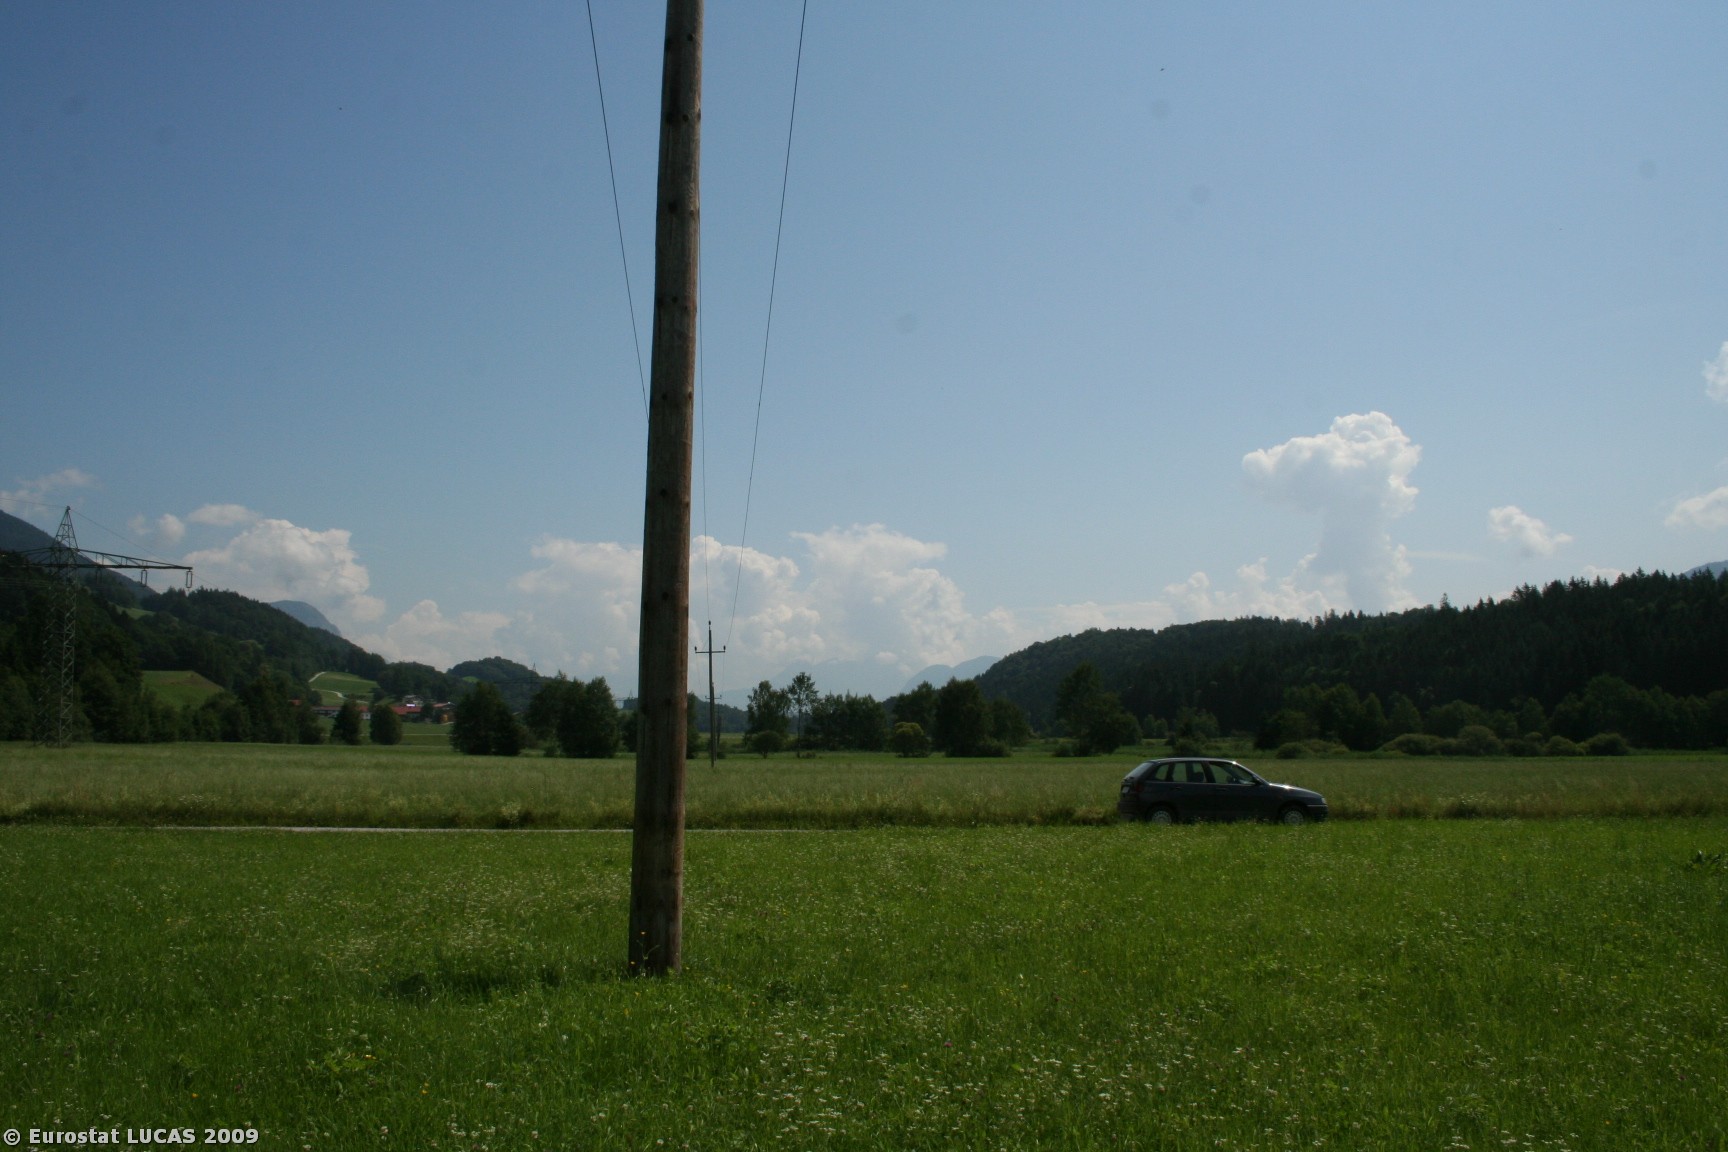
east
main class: Grassland
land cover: Grassland without tree/shrub cover
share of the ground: > 75 %
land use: Agriculture (excluding fallow land and kitchen gardens)
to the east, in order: Grassland without tree/shrub cover; Electric lines; Grassland without tree/shrub cover; Paved roads, cycling and walking lanes; Grassland without tree/shrub cover; Ditches and canals; Grassland without tree/shrub cover; Rivers and streams; Grassland without tree/shrub cover; Shruby margins; Rivers and streams; Grassland without tree/shrub cover
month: July
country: AT
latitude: 47.4687
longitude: 11.9223
